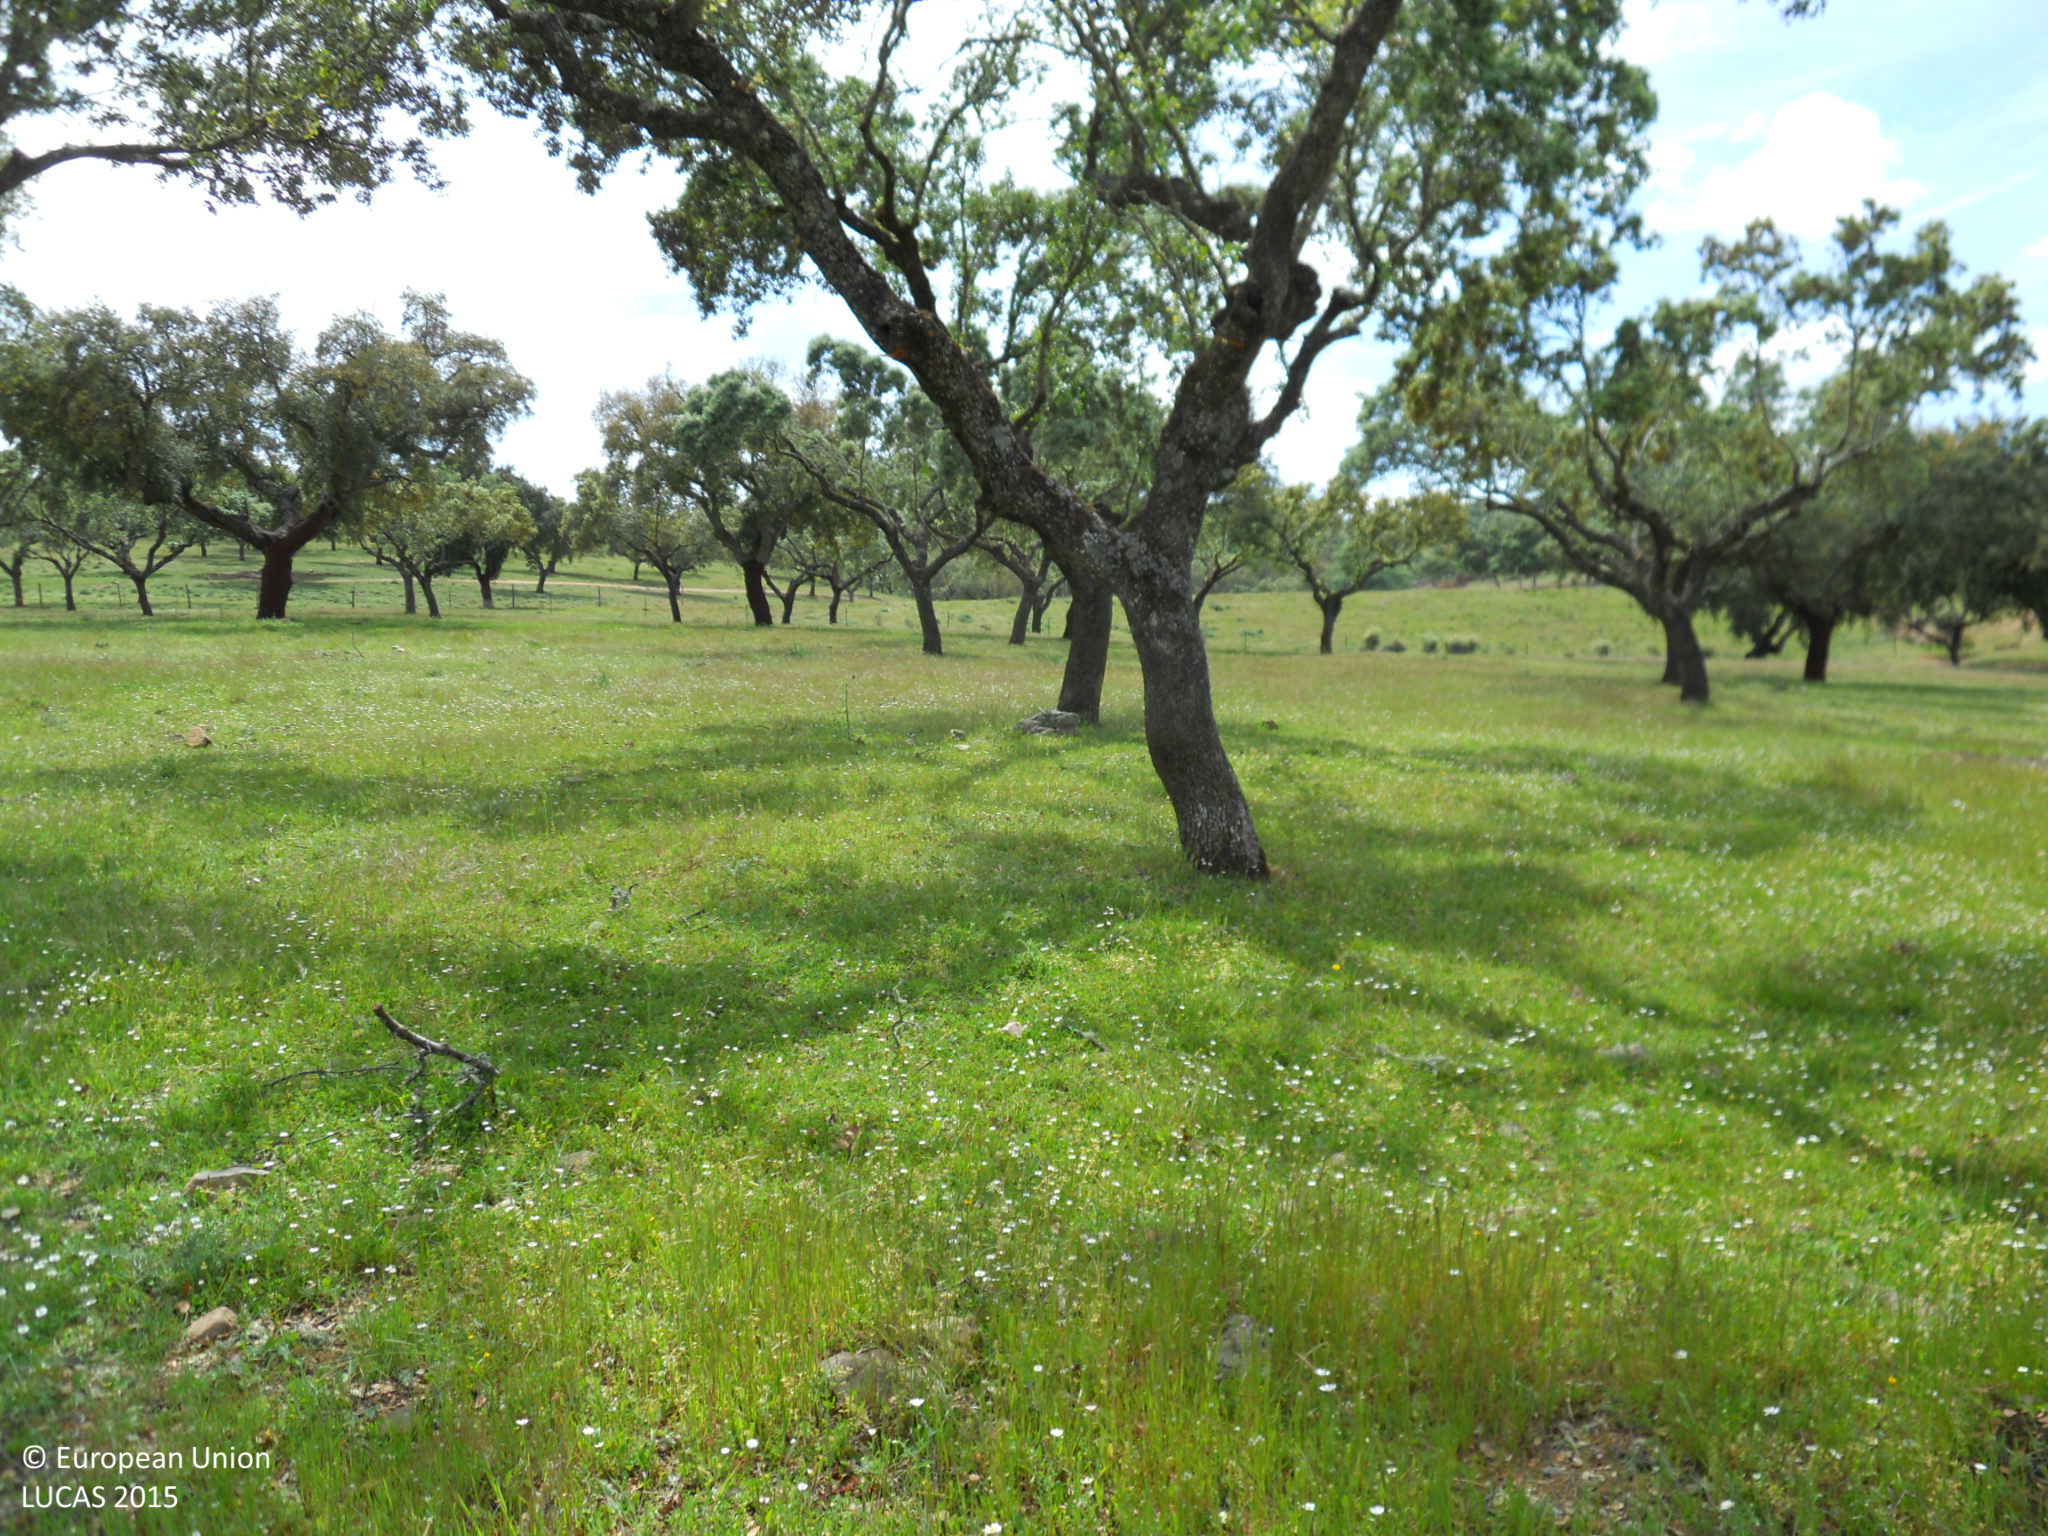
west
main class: Woodland
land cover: Broadleaved woodland
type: broadleaved evergreen forest
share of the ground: > 75 %
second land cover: Grassland without tree/shrub cover
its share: > 75 %
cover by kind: broadleaved forest trees 80 %, herbaceous plants 20 %
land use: Forestry
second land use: Agriculture (excluding fallow land and kitchen gardens)
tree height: > 5 m
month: April
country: ES
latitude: 39.3213
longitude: -6.5990
